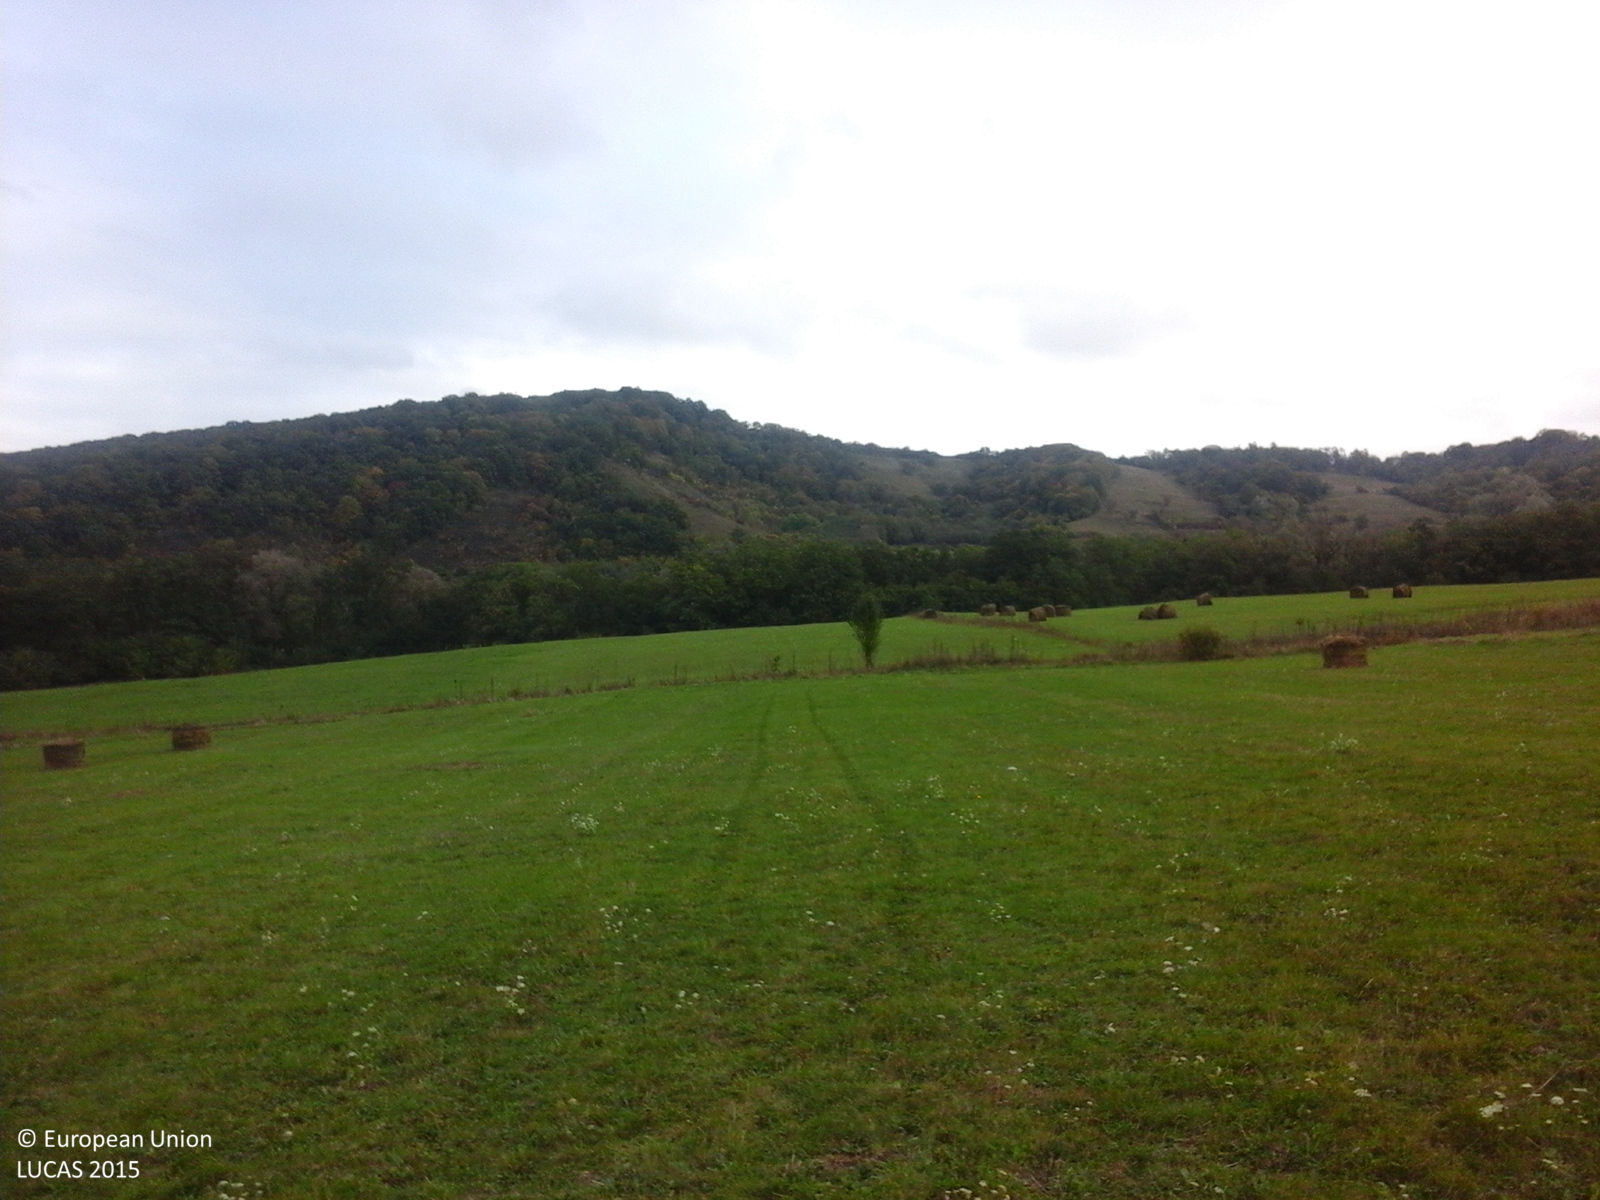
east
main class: Grassland
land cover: Grassland without tree/shrub cover
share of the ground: > 75 %
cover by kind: herbaceous plants 100 %
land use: Agriculture (excluding fallow land and kitchen gardens)
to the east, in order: Grassland without tree/shrub cover; Tracks; Grassland without tree/shrub cover
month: October
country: RO
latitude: 45.9077
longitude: 24.8763
